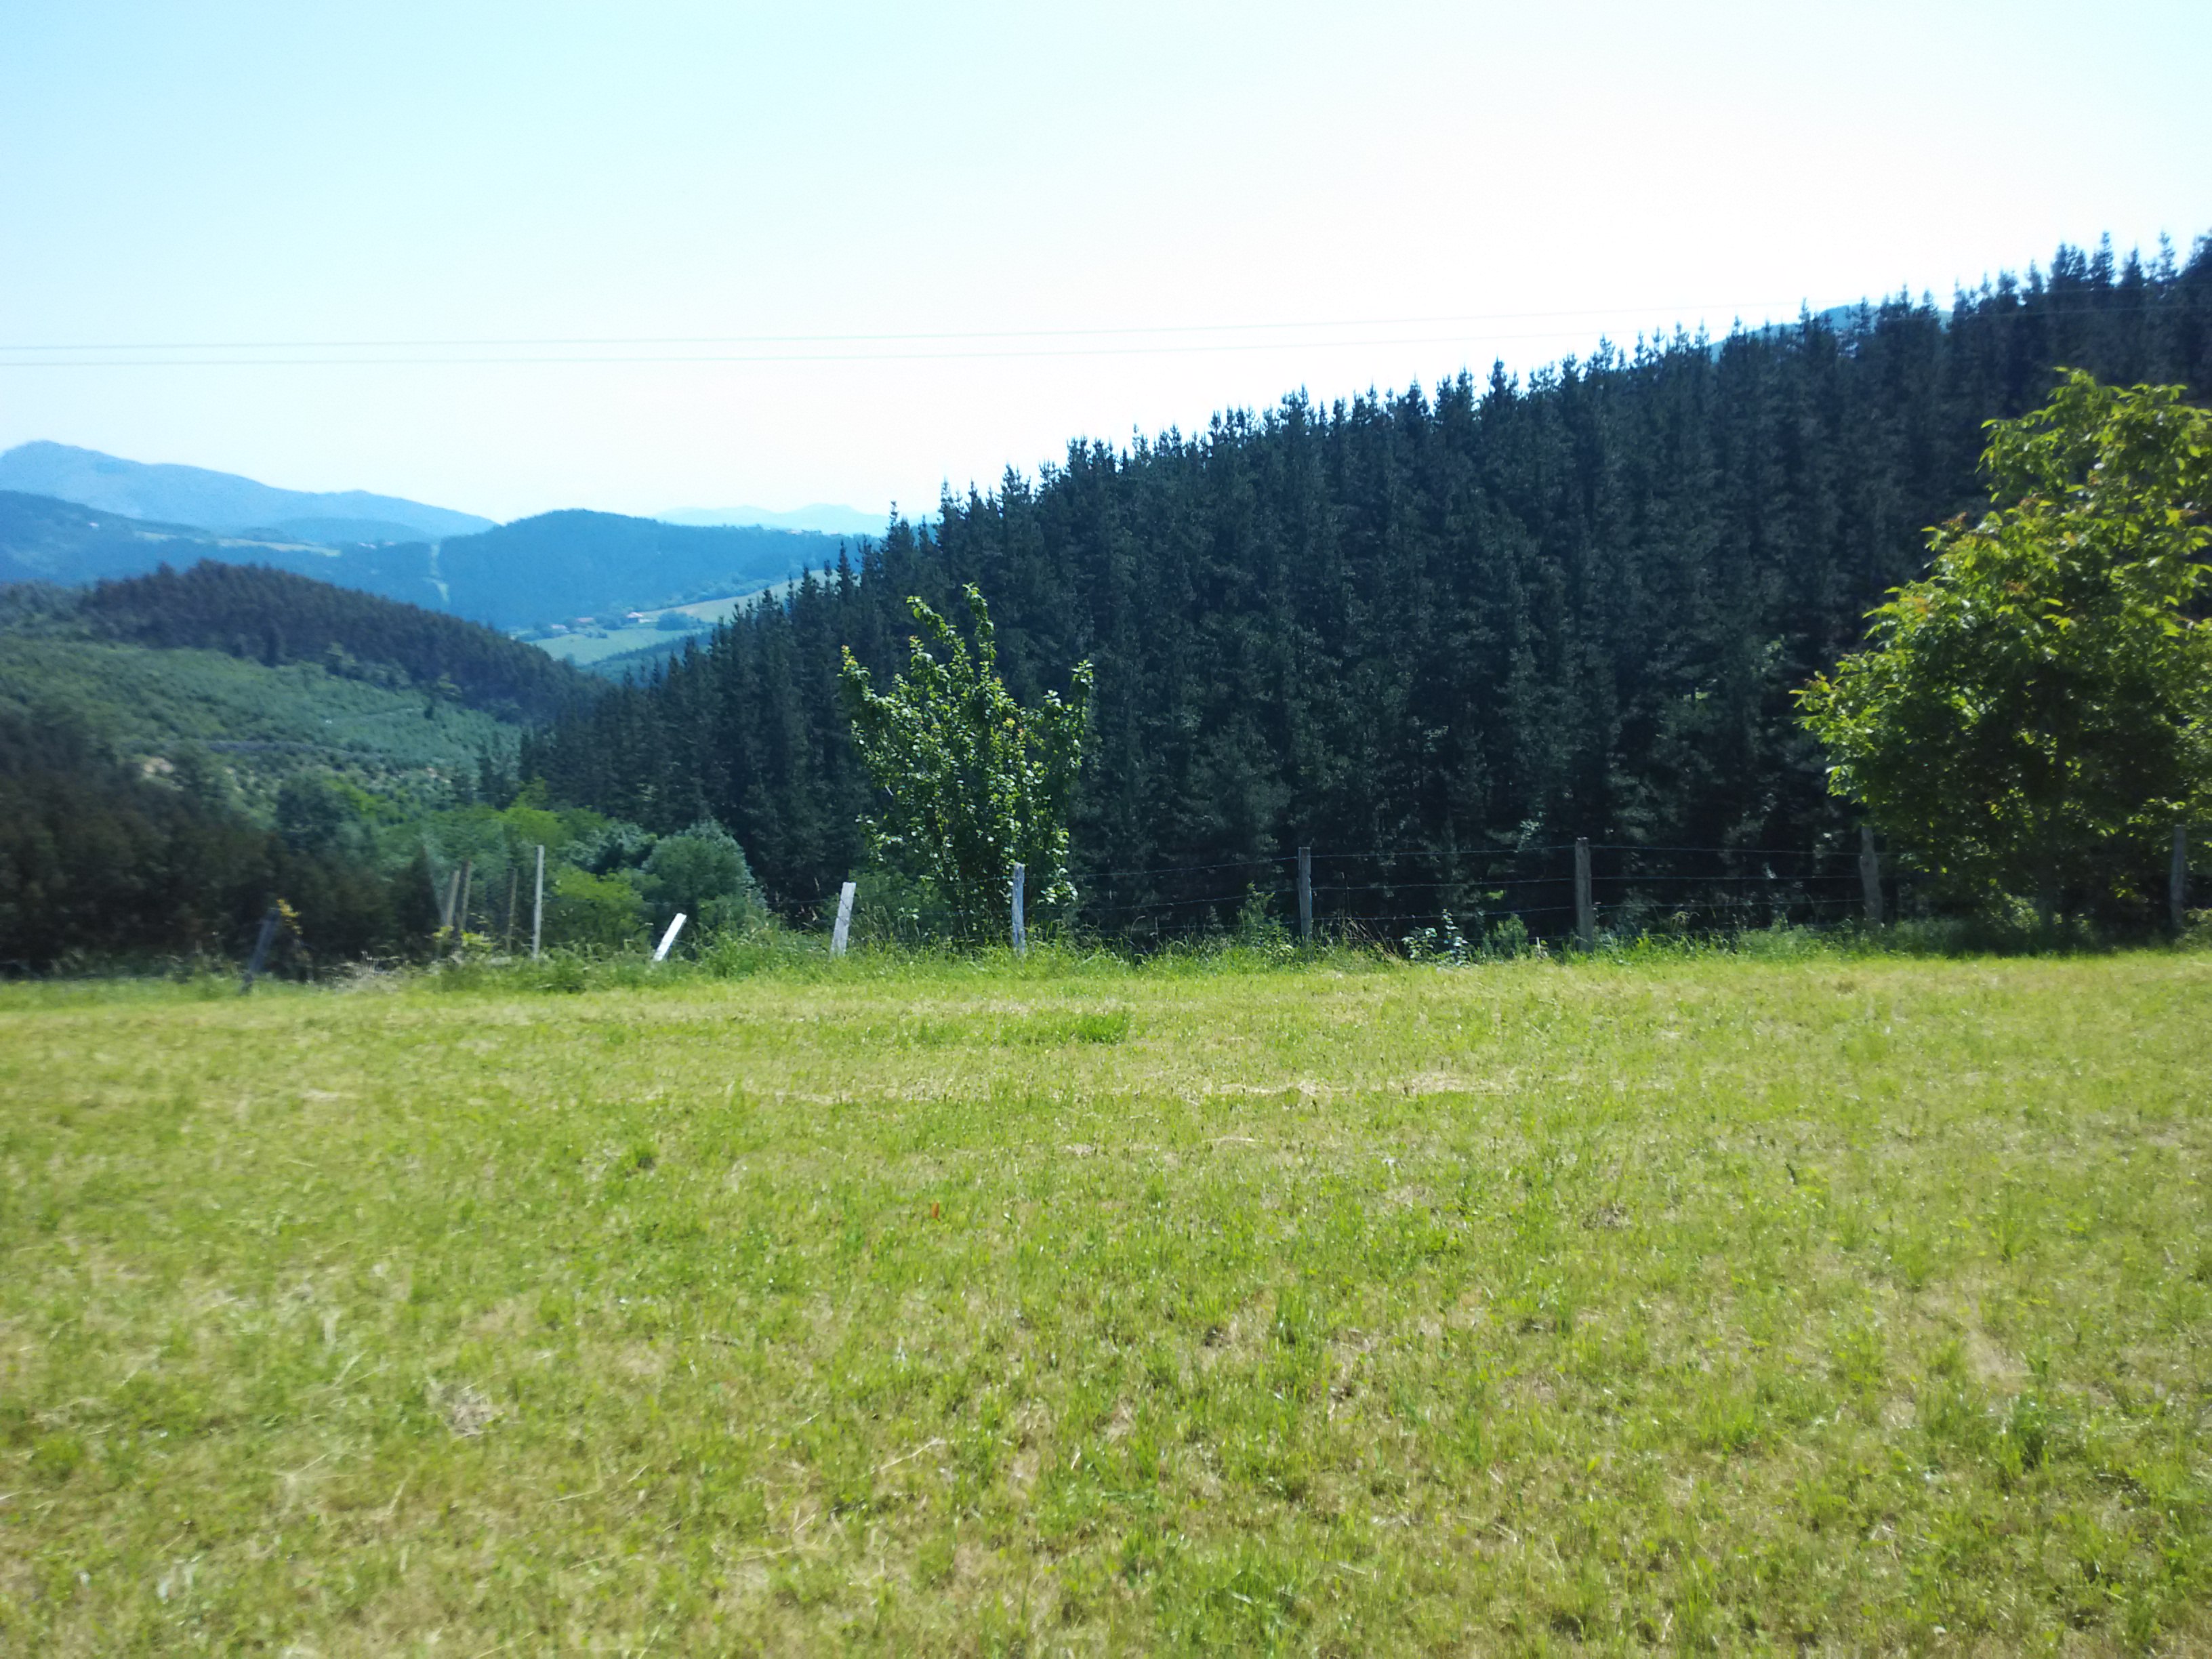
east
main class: Grassland
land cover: Grassland without tree/shrub cover
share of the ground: > 75 %
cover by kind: herbaceous plants 100 %
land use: Agriculture (excluding fallow land and kitchen gardens)
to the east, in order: Grassland without tree/shrub cover; Grassland with sparse tree/shrub cover; Fences; Tracks; Electric lines; Grassland without tree/shrub cover; Broadleaved woodland; Rivers and streams; Broadleaved woodland; Pine dominated coniferous woodland
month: June
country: ES
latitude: 43.2502
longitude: -2.6050
